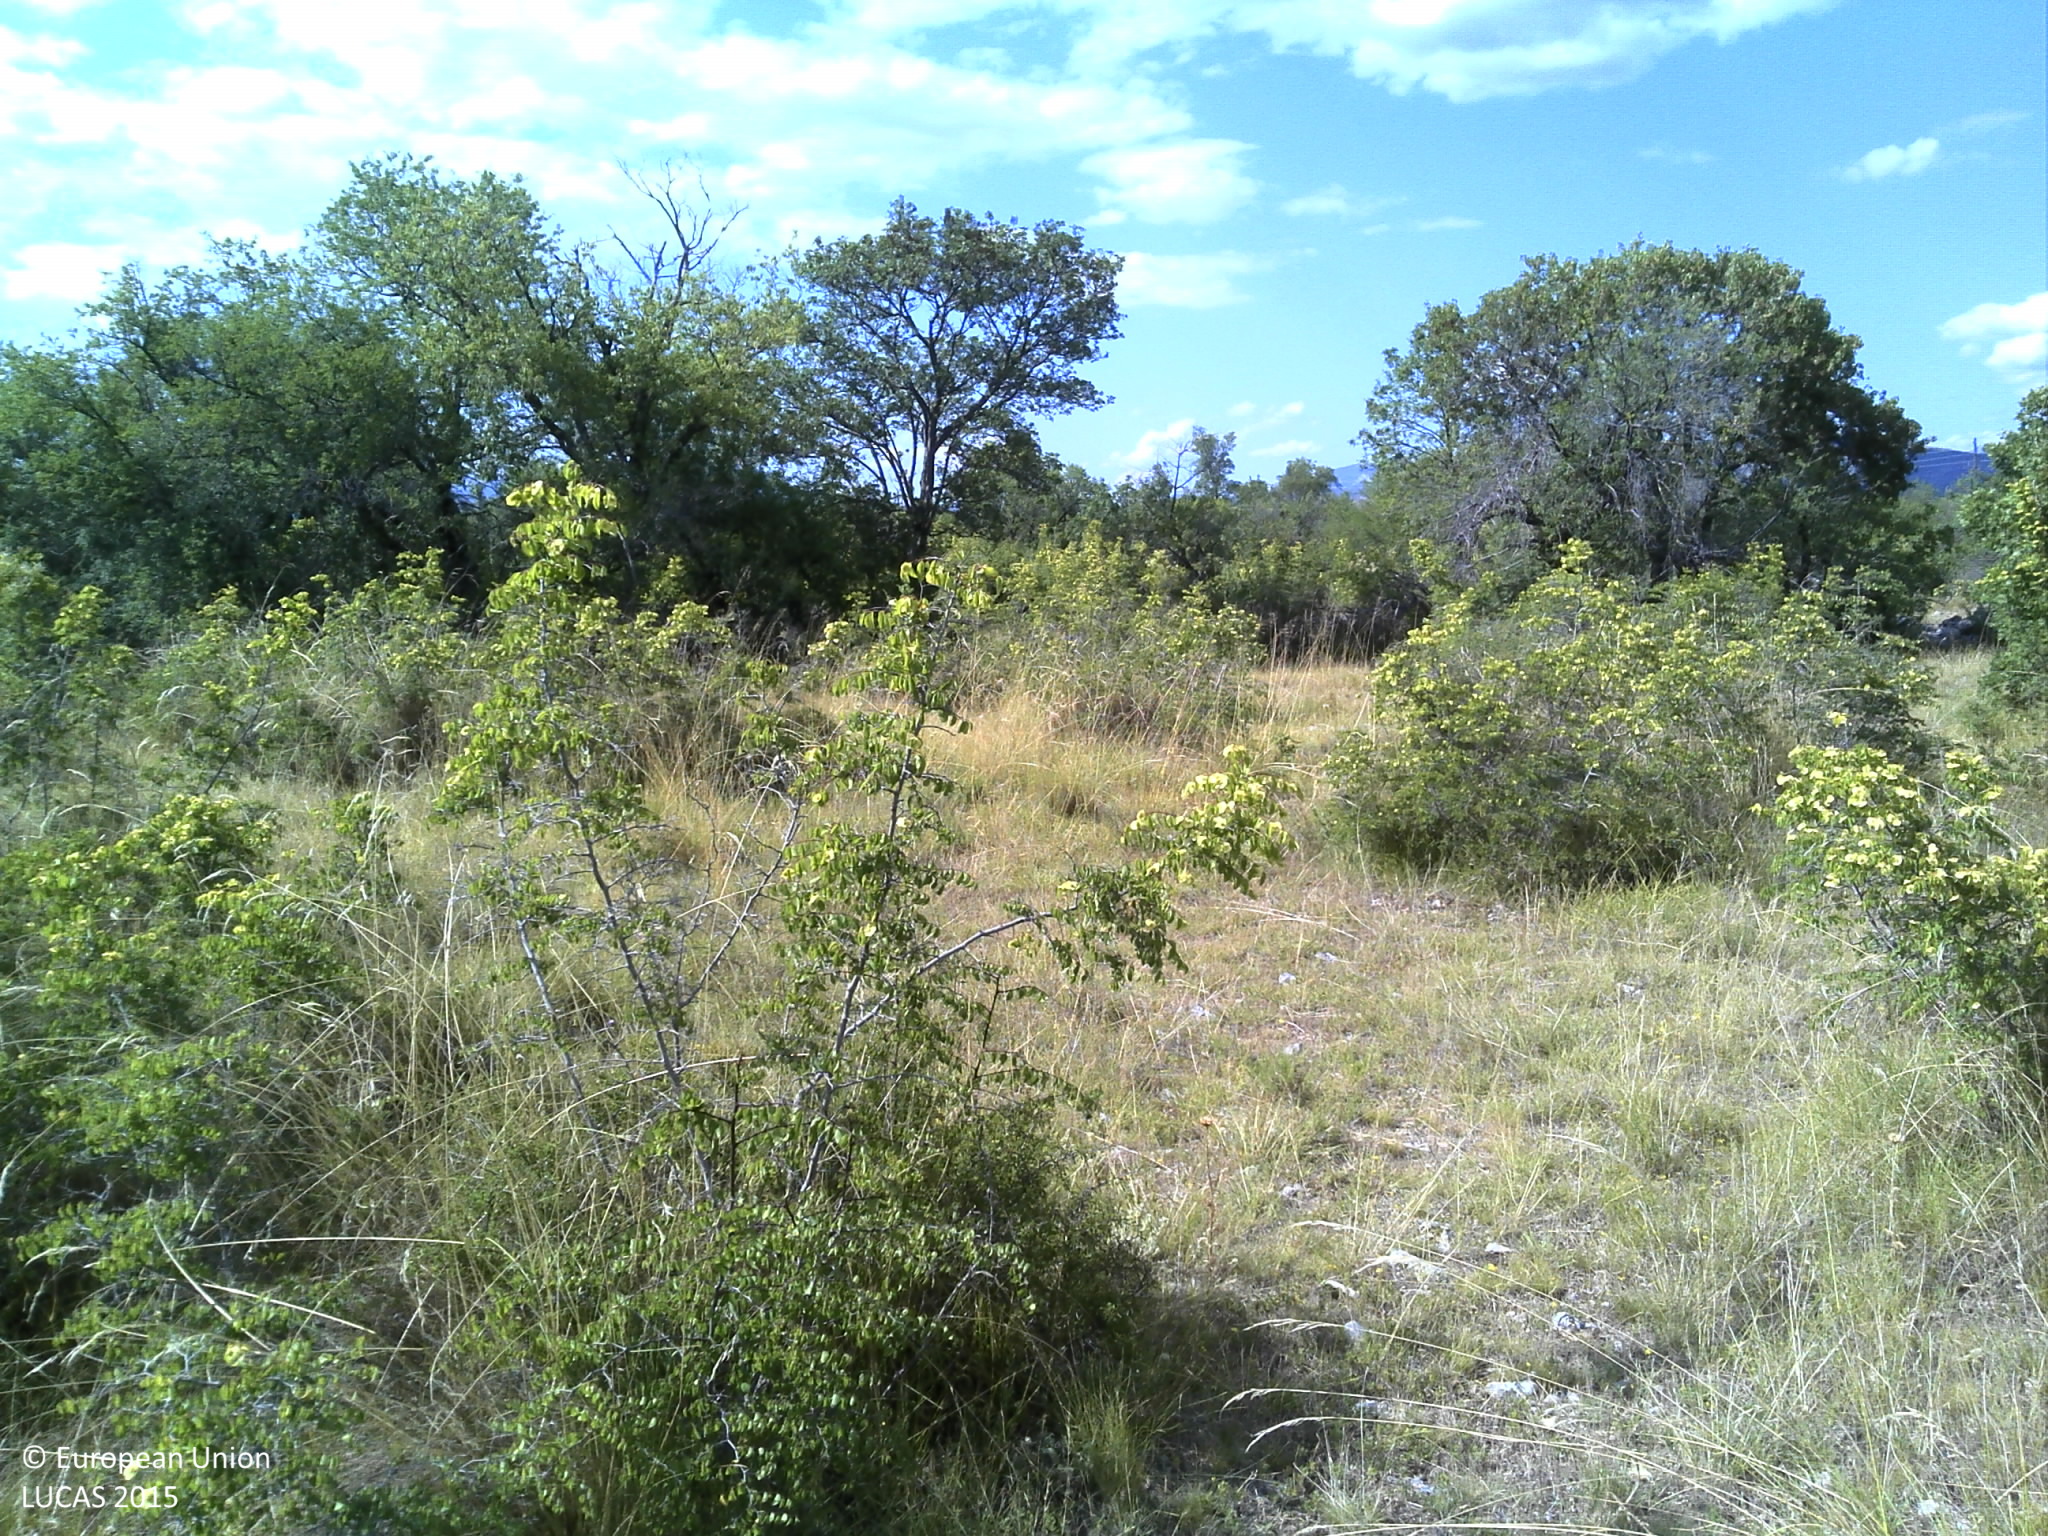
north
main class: Shrubland
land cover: Shrubland with sparse tree cover
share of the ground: 50 - 75 %
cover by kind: shrubs 55 %, herbaceous plants 35 %, broadleaved forest trees 5 %, consolidated bare surface 5 %
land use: Semi-natural and natural areas not in use
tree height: < 5 m
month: July
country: HR
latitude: 44.0073
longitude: 16.1162
